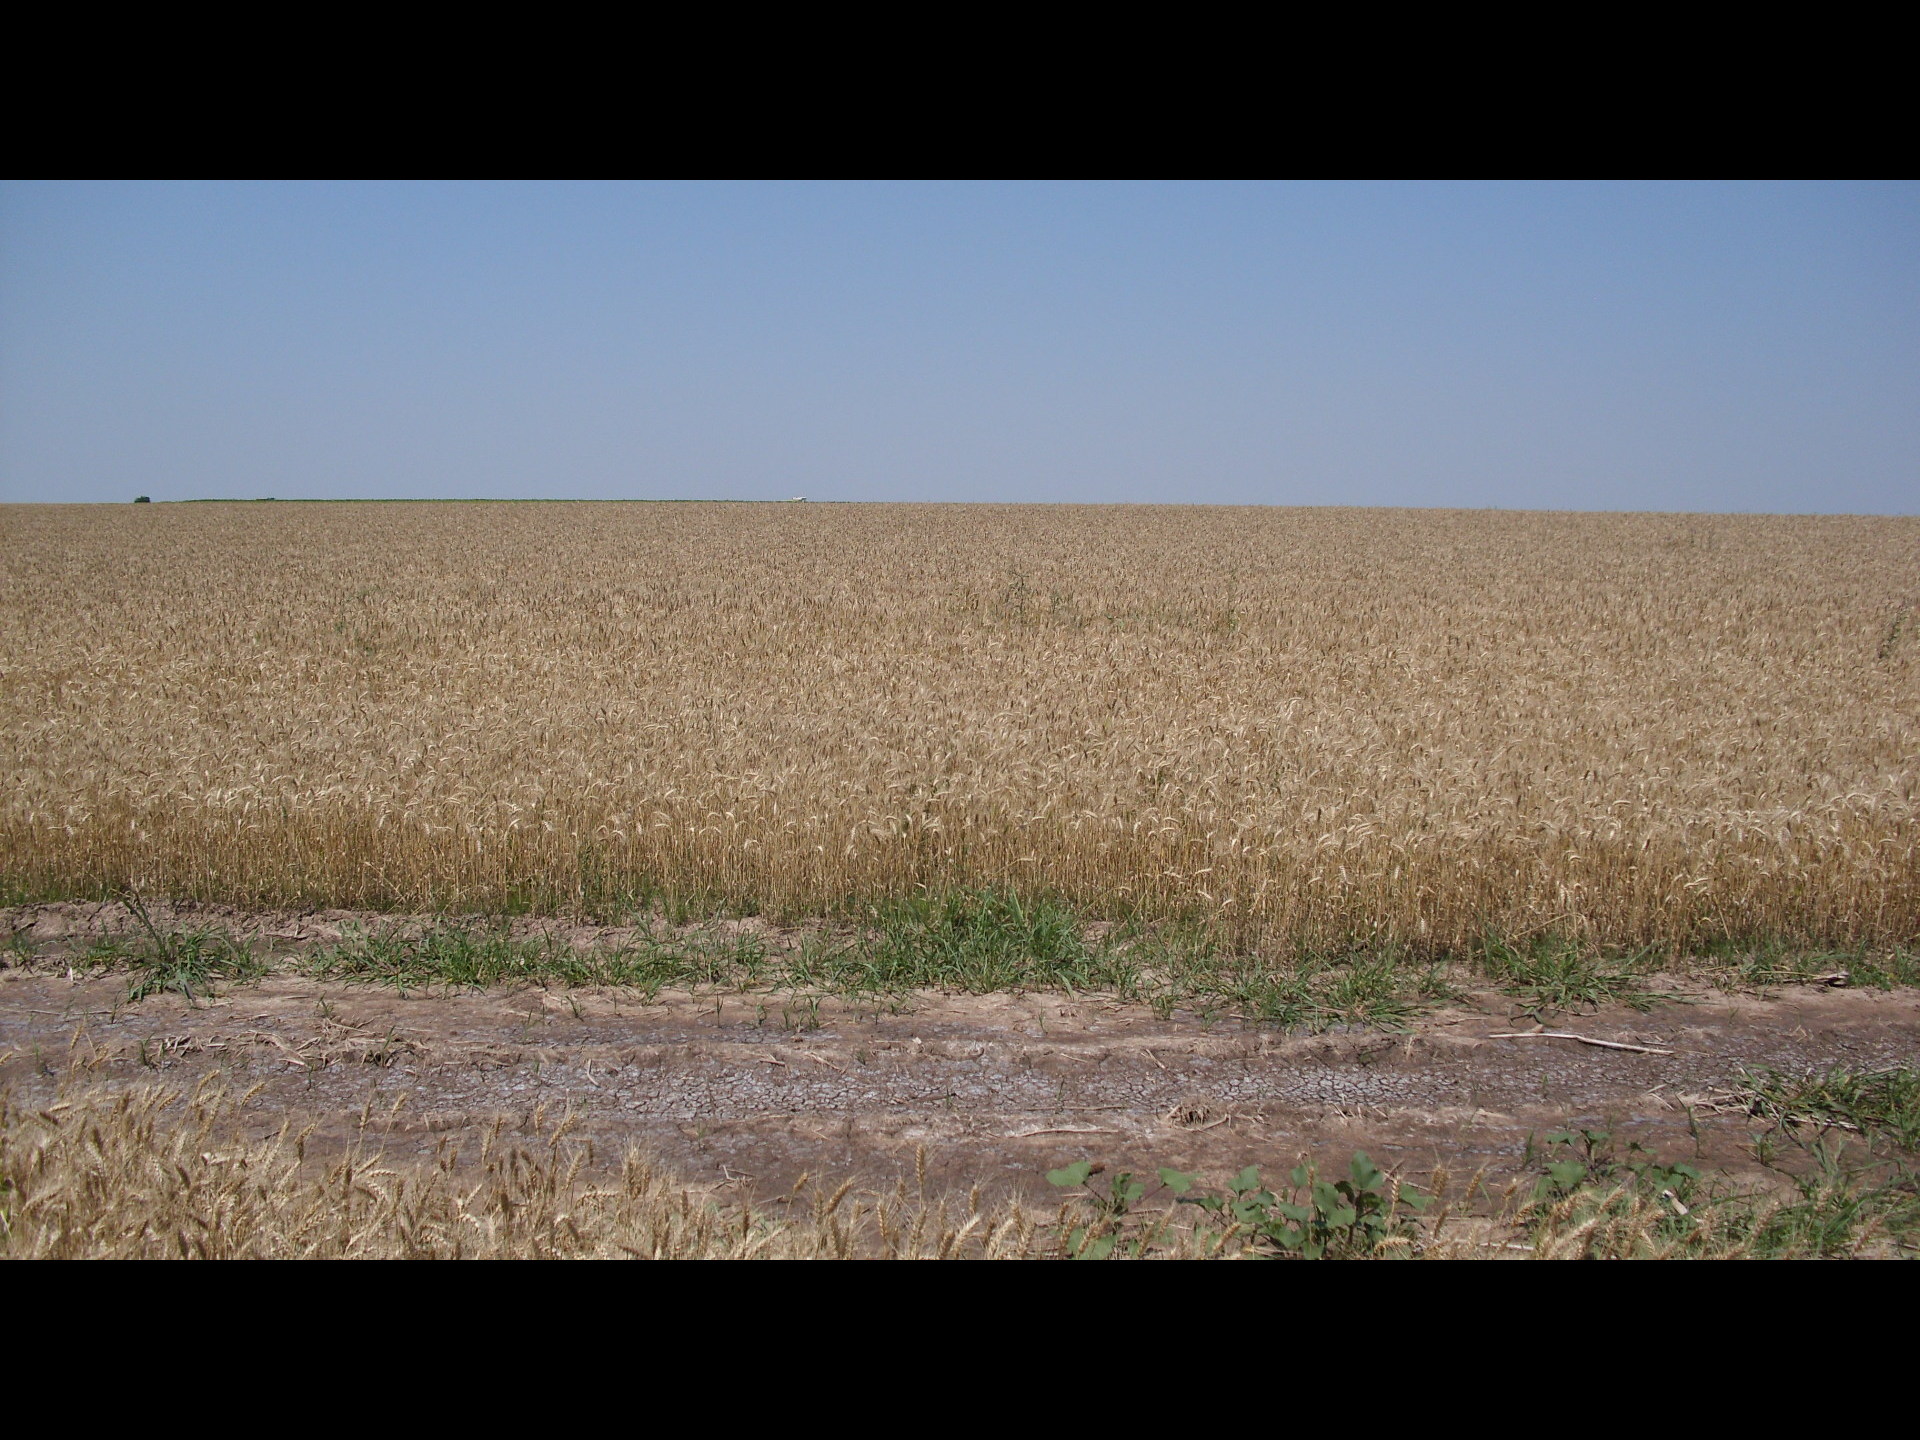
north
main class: Cropland
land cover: Common wheat
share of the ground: > 75 %
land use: Agriculture (excluding fallow land and kitchen gardens)
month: June
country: BG
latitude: 43.6225
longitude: 23.2650
